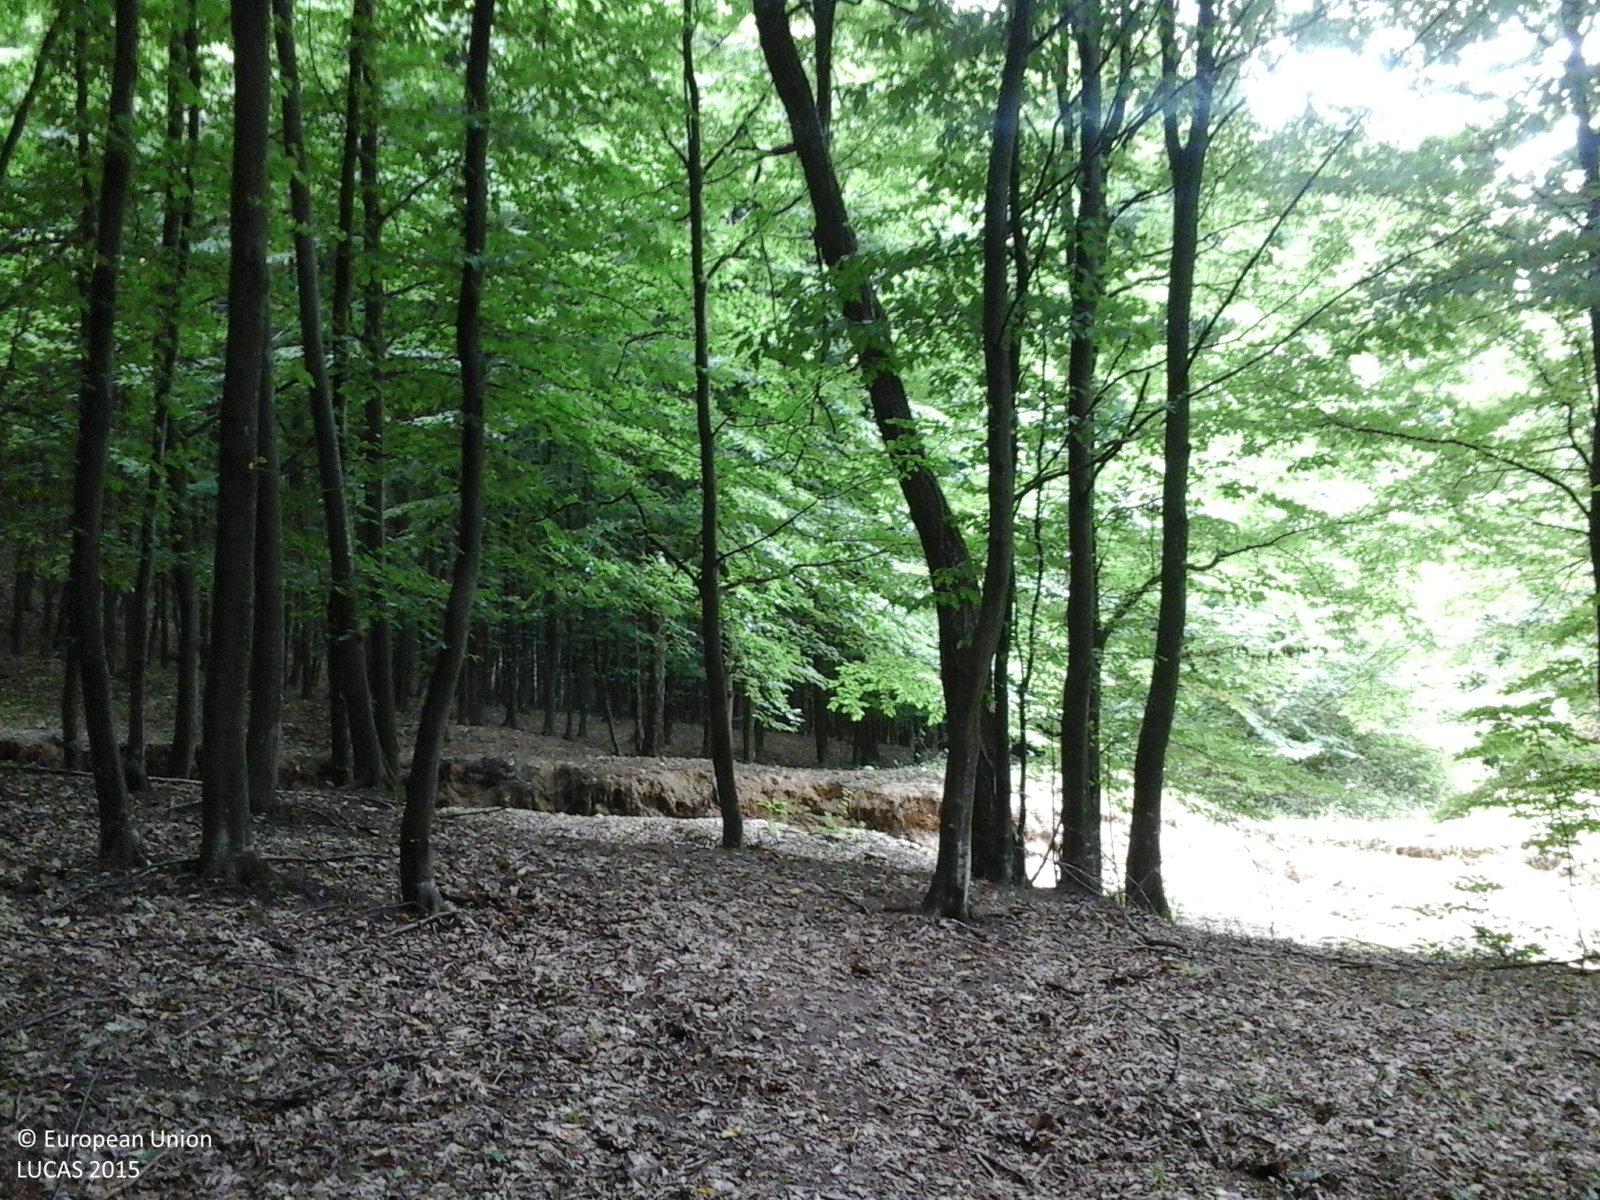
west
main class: Woodland
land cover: Broadleaved woodland
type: beech forest
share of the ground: > 75 %
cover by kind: broadleaved forest trees 100 %
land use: Forestry
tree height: > 5 m
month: July
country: RO
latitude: 44.8325
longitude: 24.4551
